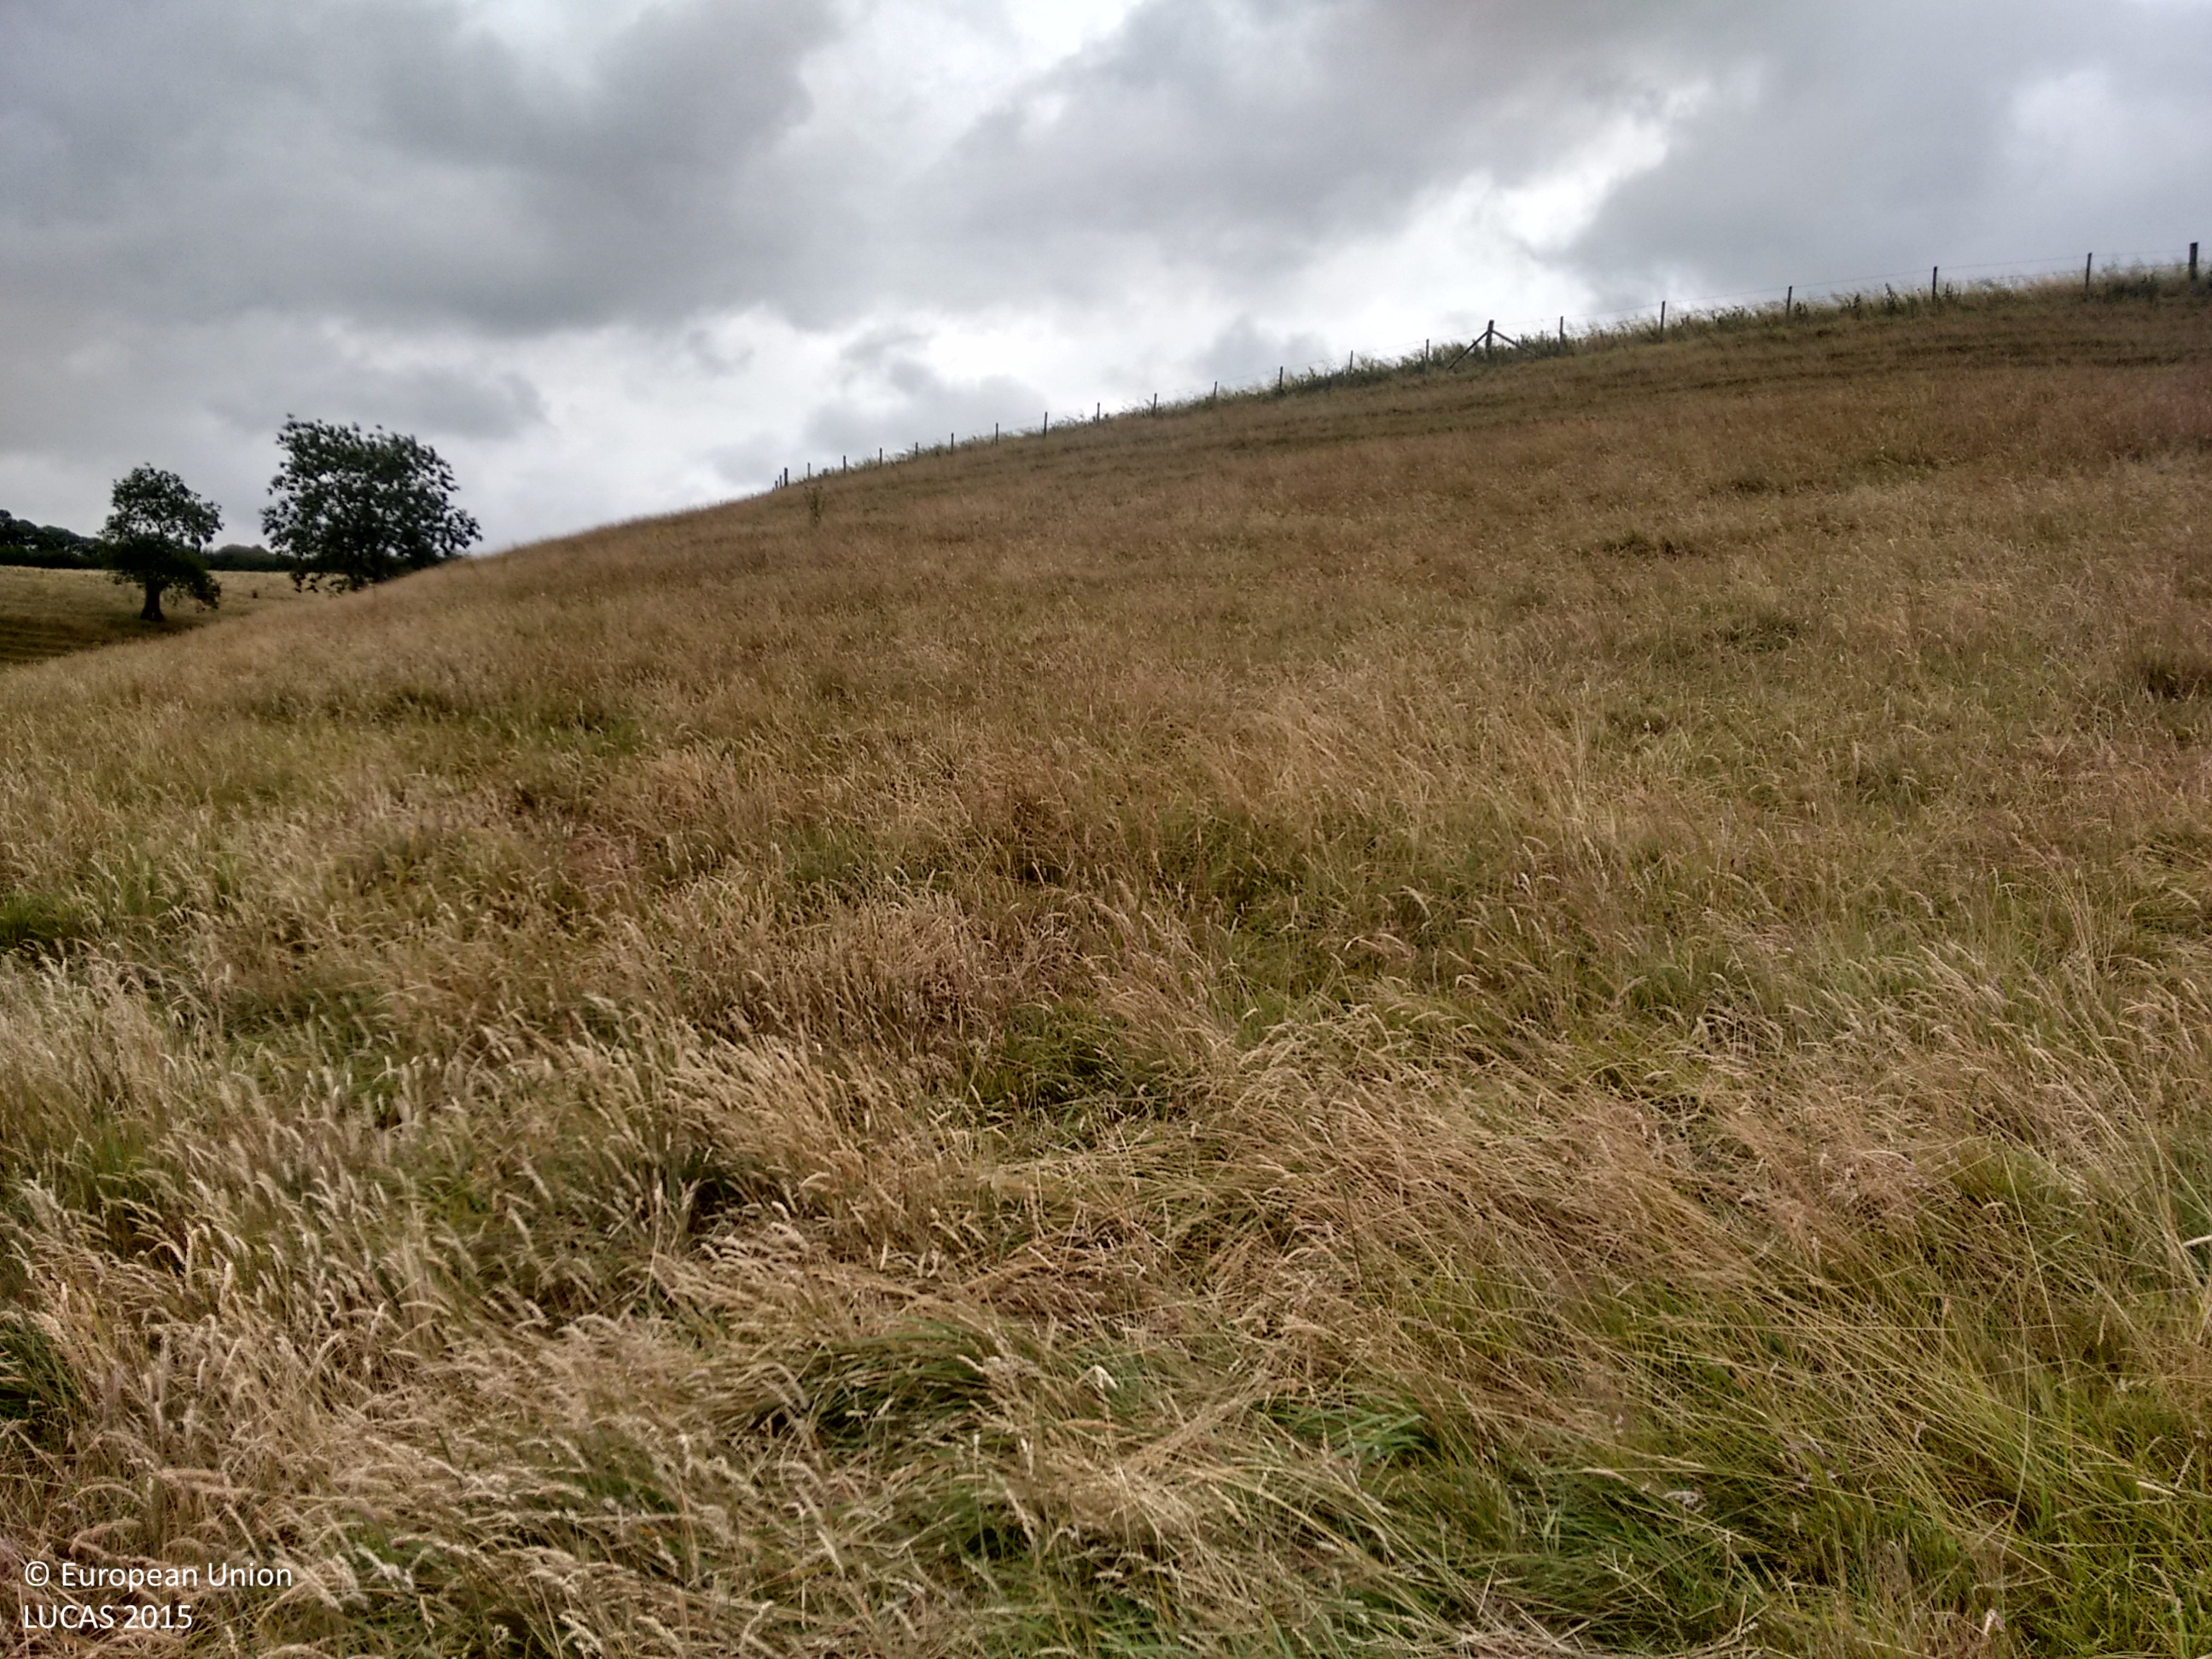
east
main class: Grassland
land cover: Grassland without tree/shrub cover
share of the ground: > 75 %
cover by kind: herbaceous plants 100 %
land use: Agriculture (excluding fallow land and kitchen gardens)
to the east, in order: Grassland without tree/shrub cover; Fences; Shruby margins; Grassland without tree/shrub cover; Managed hedges; Grassland without tree/shrub cover
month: July
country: GB
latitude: 51.4723
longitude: -2.3736
